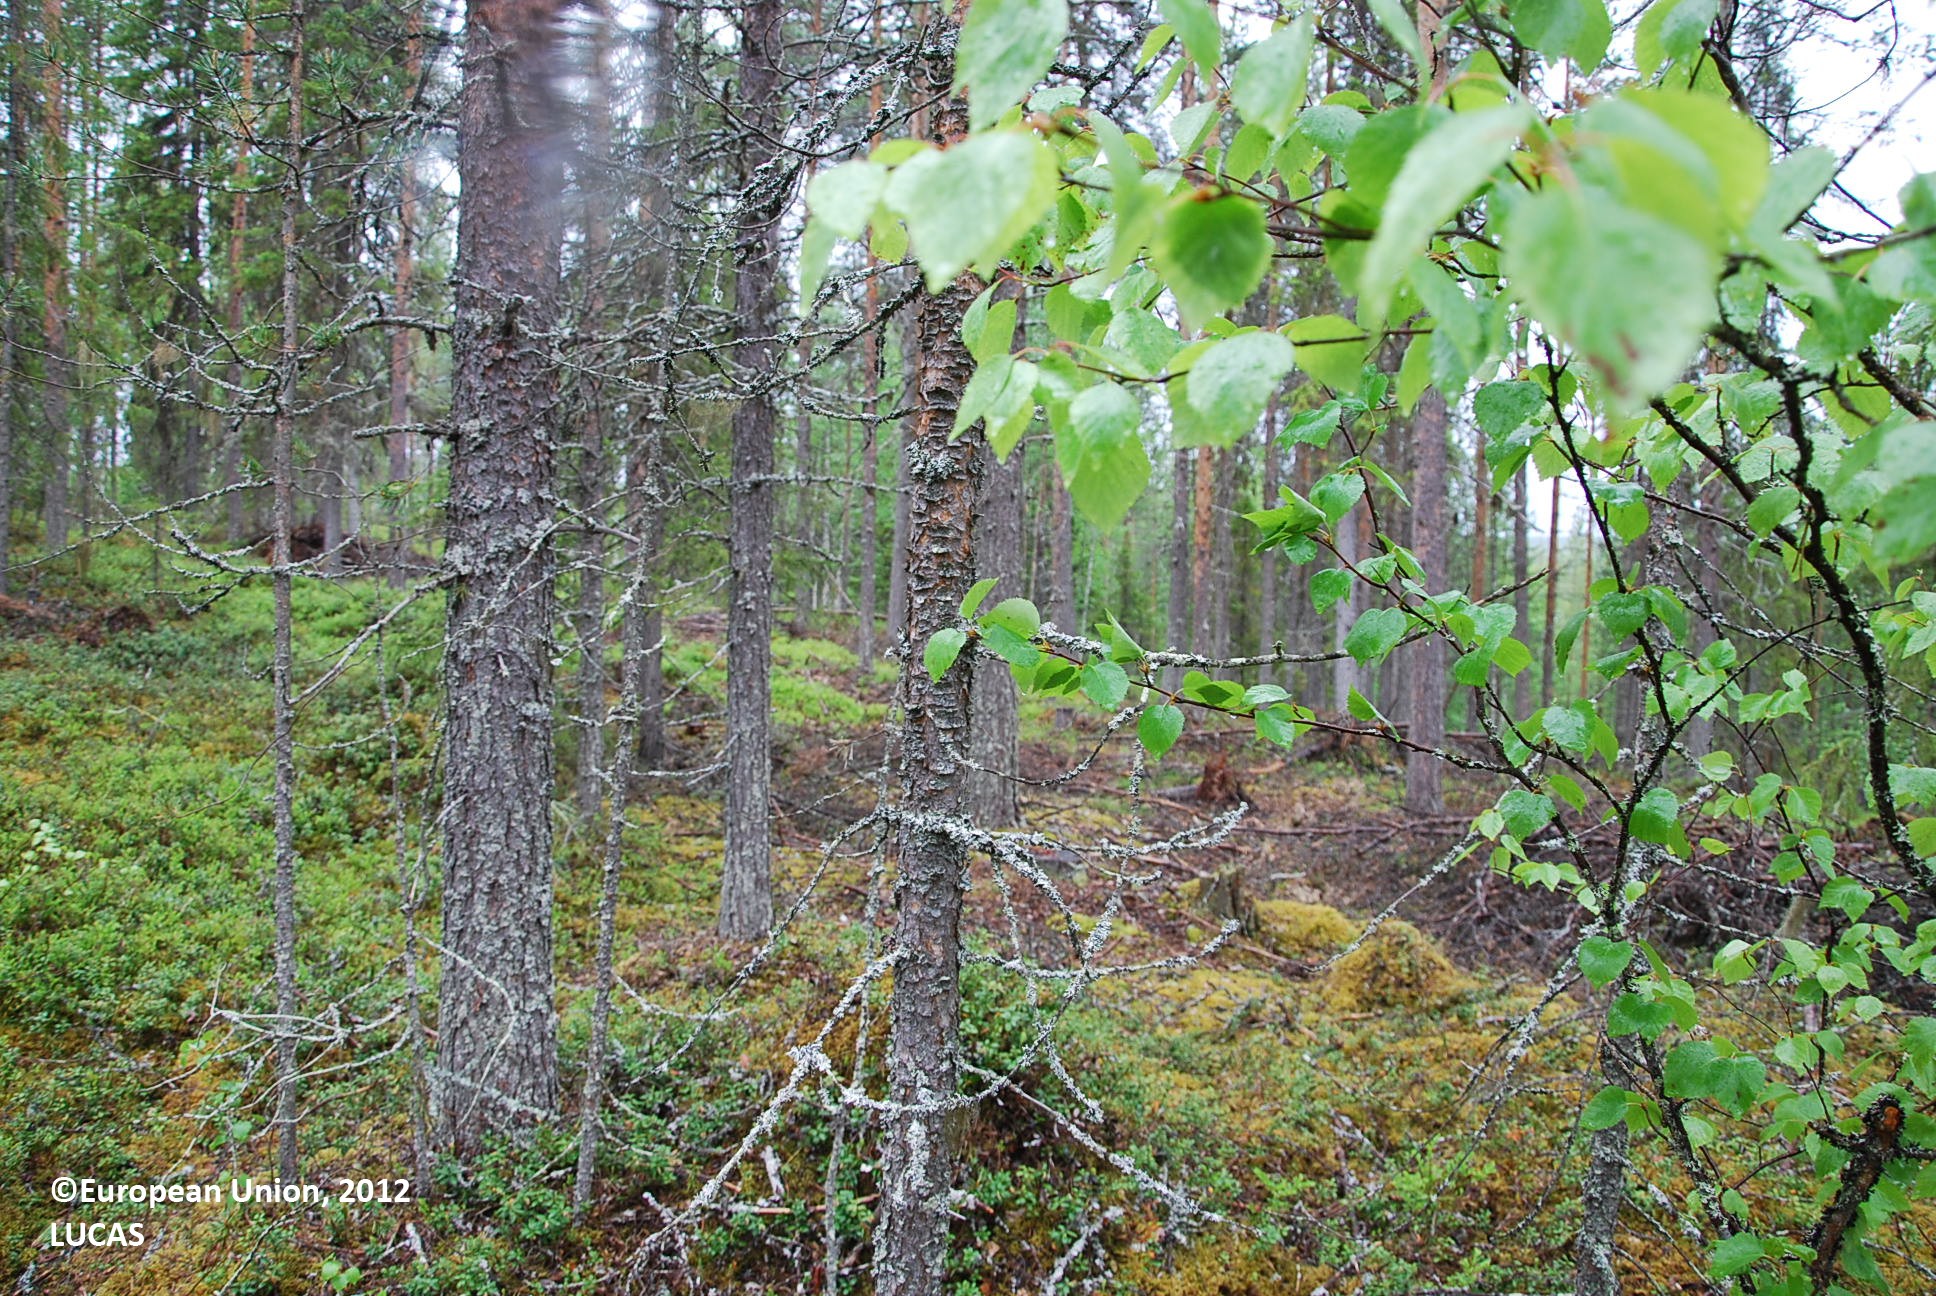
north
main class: Woodland
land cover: Other coniferous woodland
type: boreal forest
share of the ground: > 75 %
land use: Forestry
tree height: > 5 m
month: June
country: FI
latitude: 66.2647
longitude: 26.9565
